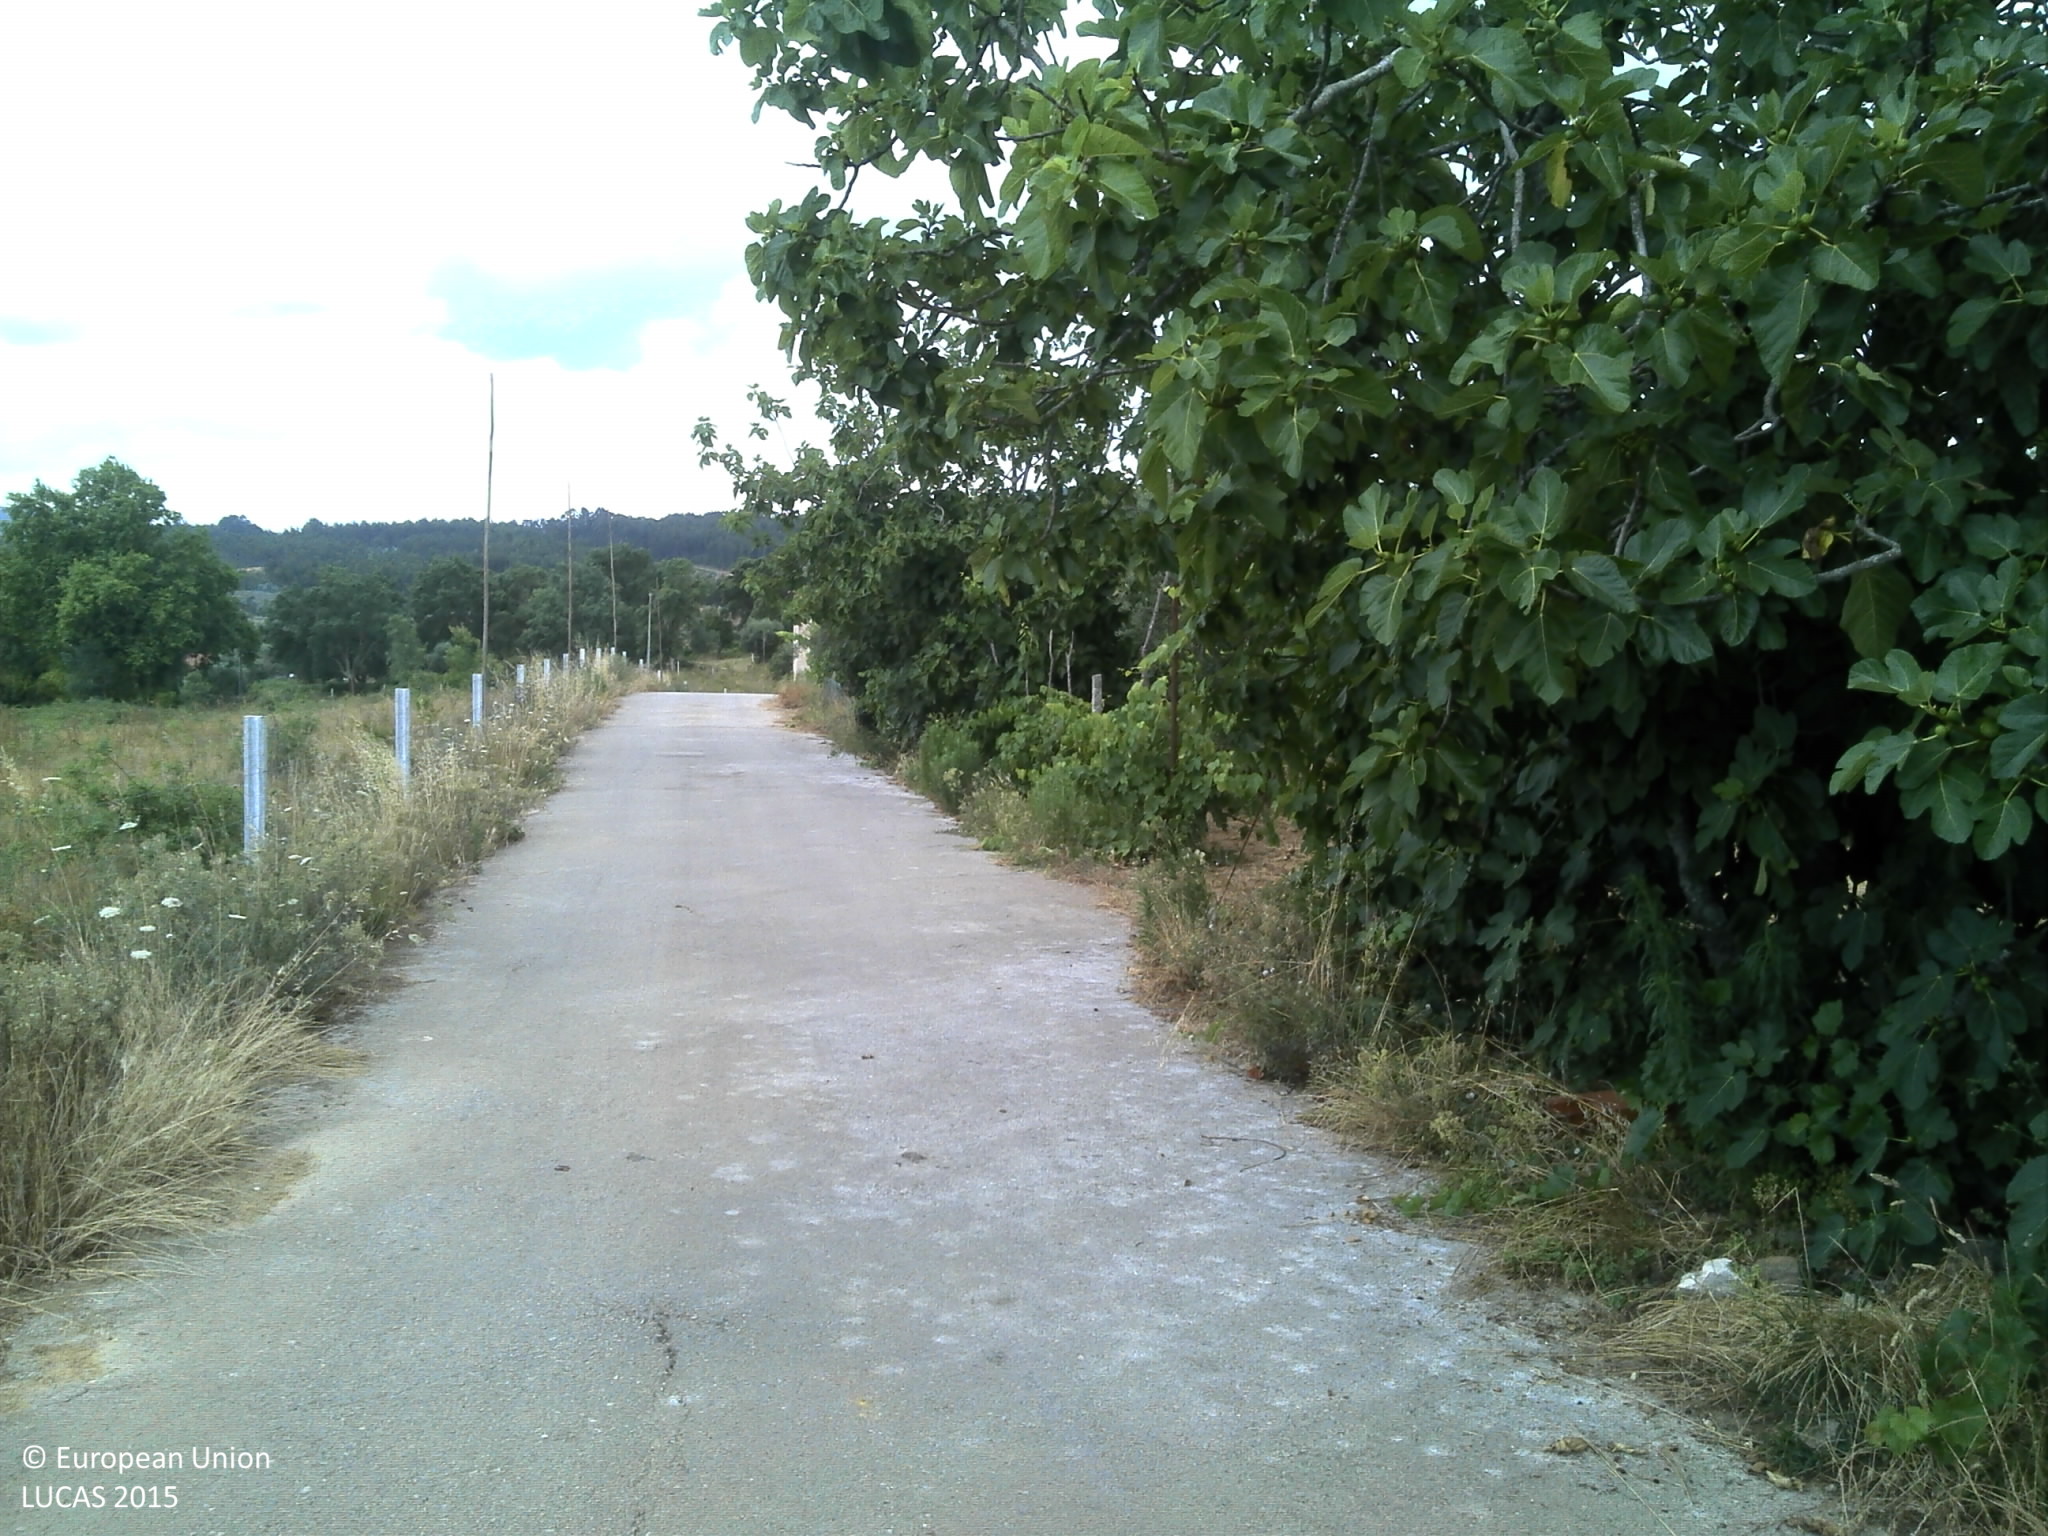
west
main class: Grassland
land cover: Spontaneously vegetated surfaces
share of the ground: > 75 %
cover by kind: herbaceous plants 80 %, unconsolidated bare surface 20 %
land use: Fallow land
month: July
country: PT
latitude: 40.1983
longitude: -8.2757
